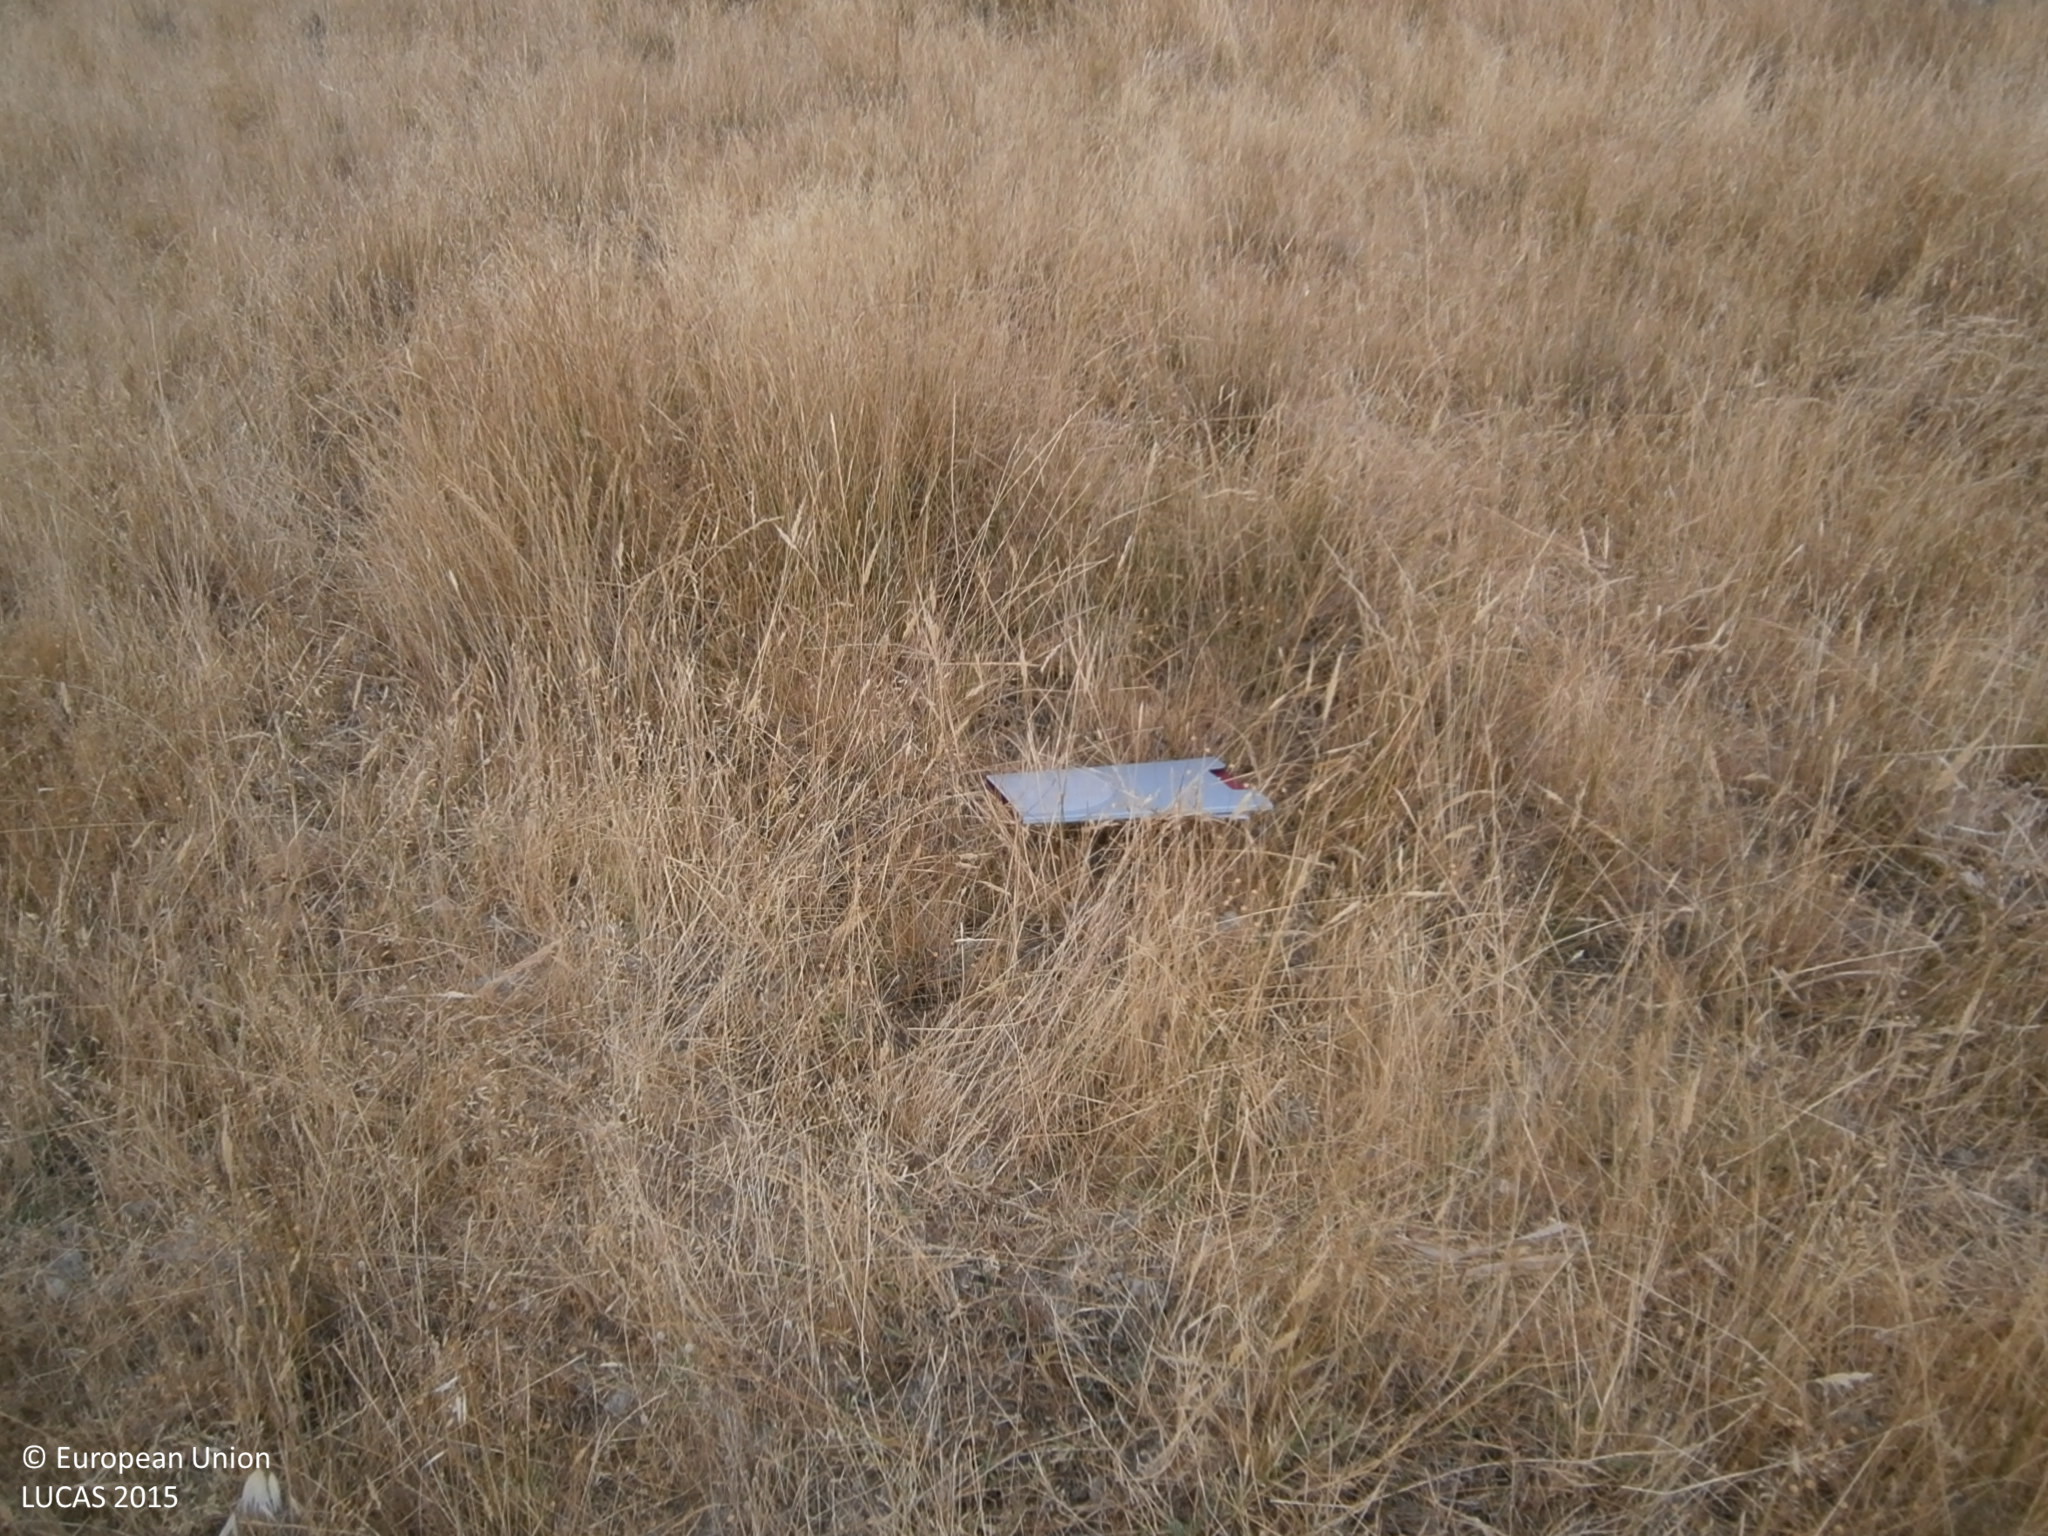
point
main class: Grassland
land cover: Grassland with sparse tree/shrub cover
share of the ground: > 75 %
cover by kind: herbaceous plants 90 %, broadleaved forest trees 5 %, shrubs 5 %
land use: Sport
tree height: > 5 m
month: June
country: ES
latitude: 38.9819
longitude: -6.3236
